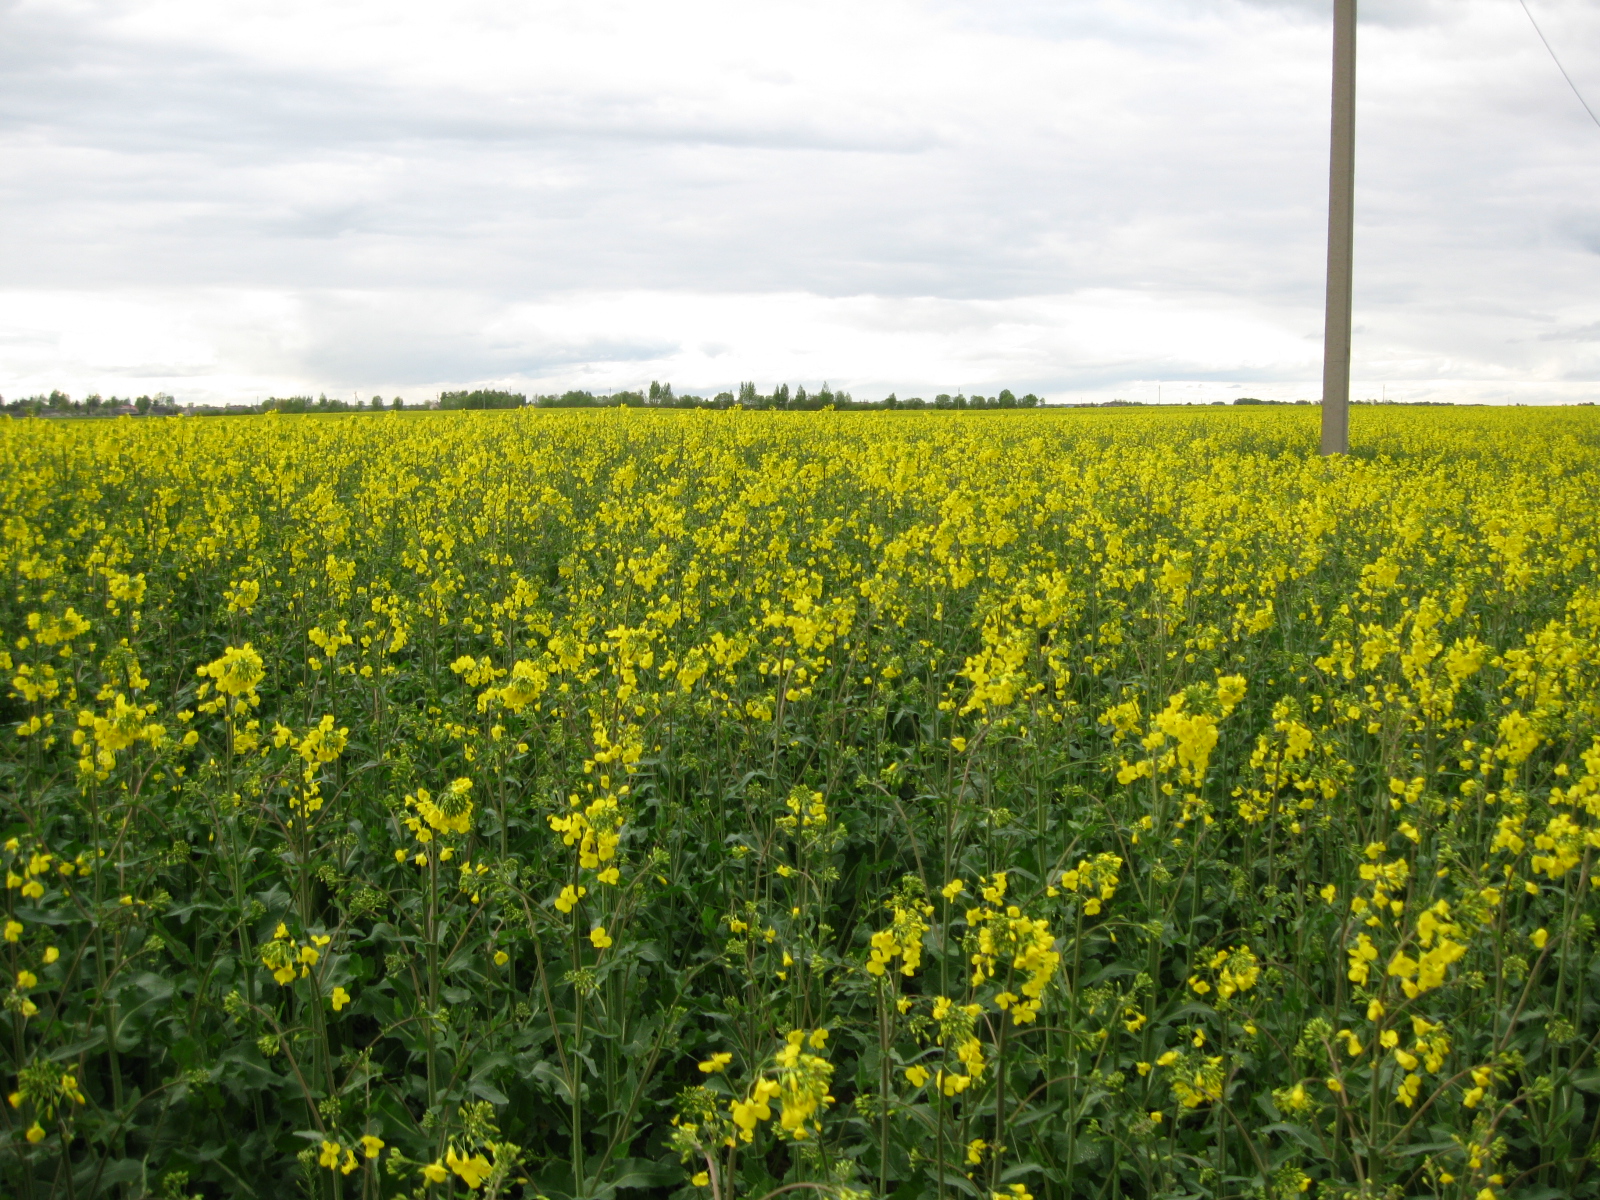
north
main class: Cropland
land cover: Rape and turnip rape
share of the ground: > 75 %
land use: Agriculture (excluding fallow land and kitchen gardens)
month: May
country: LT
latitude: 56.2806
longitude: 23.4325
